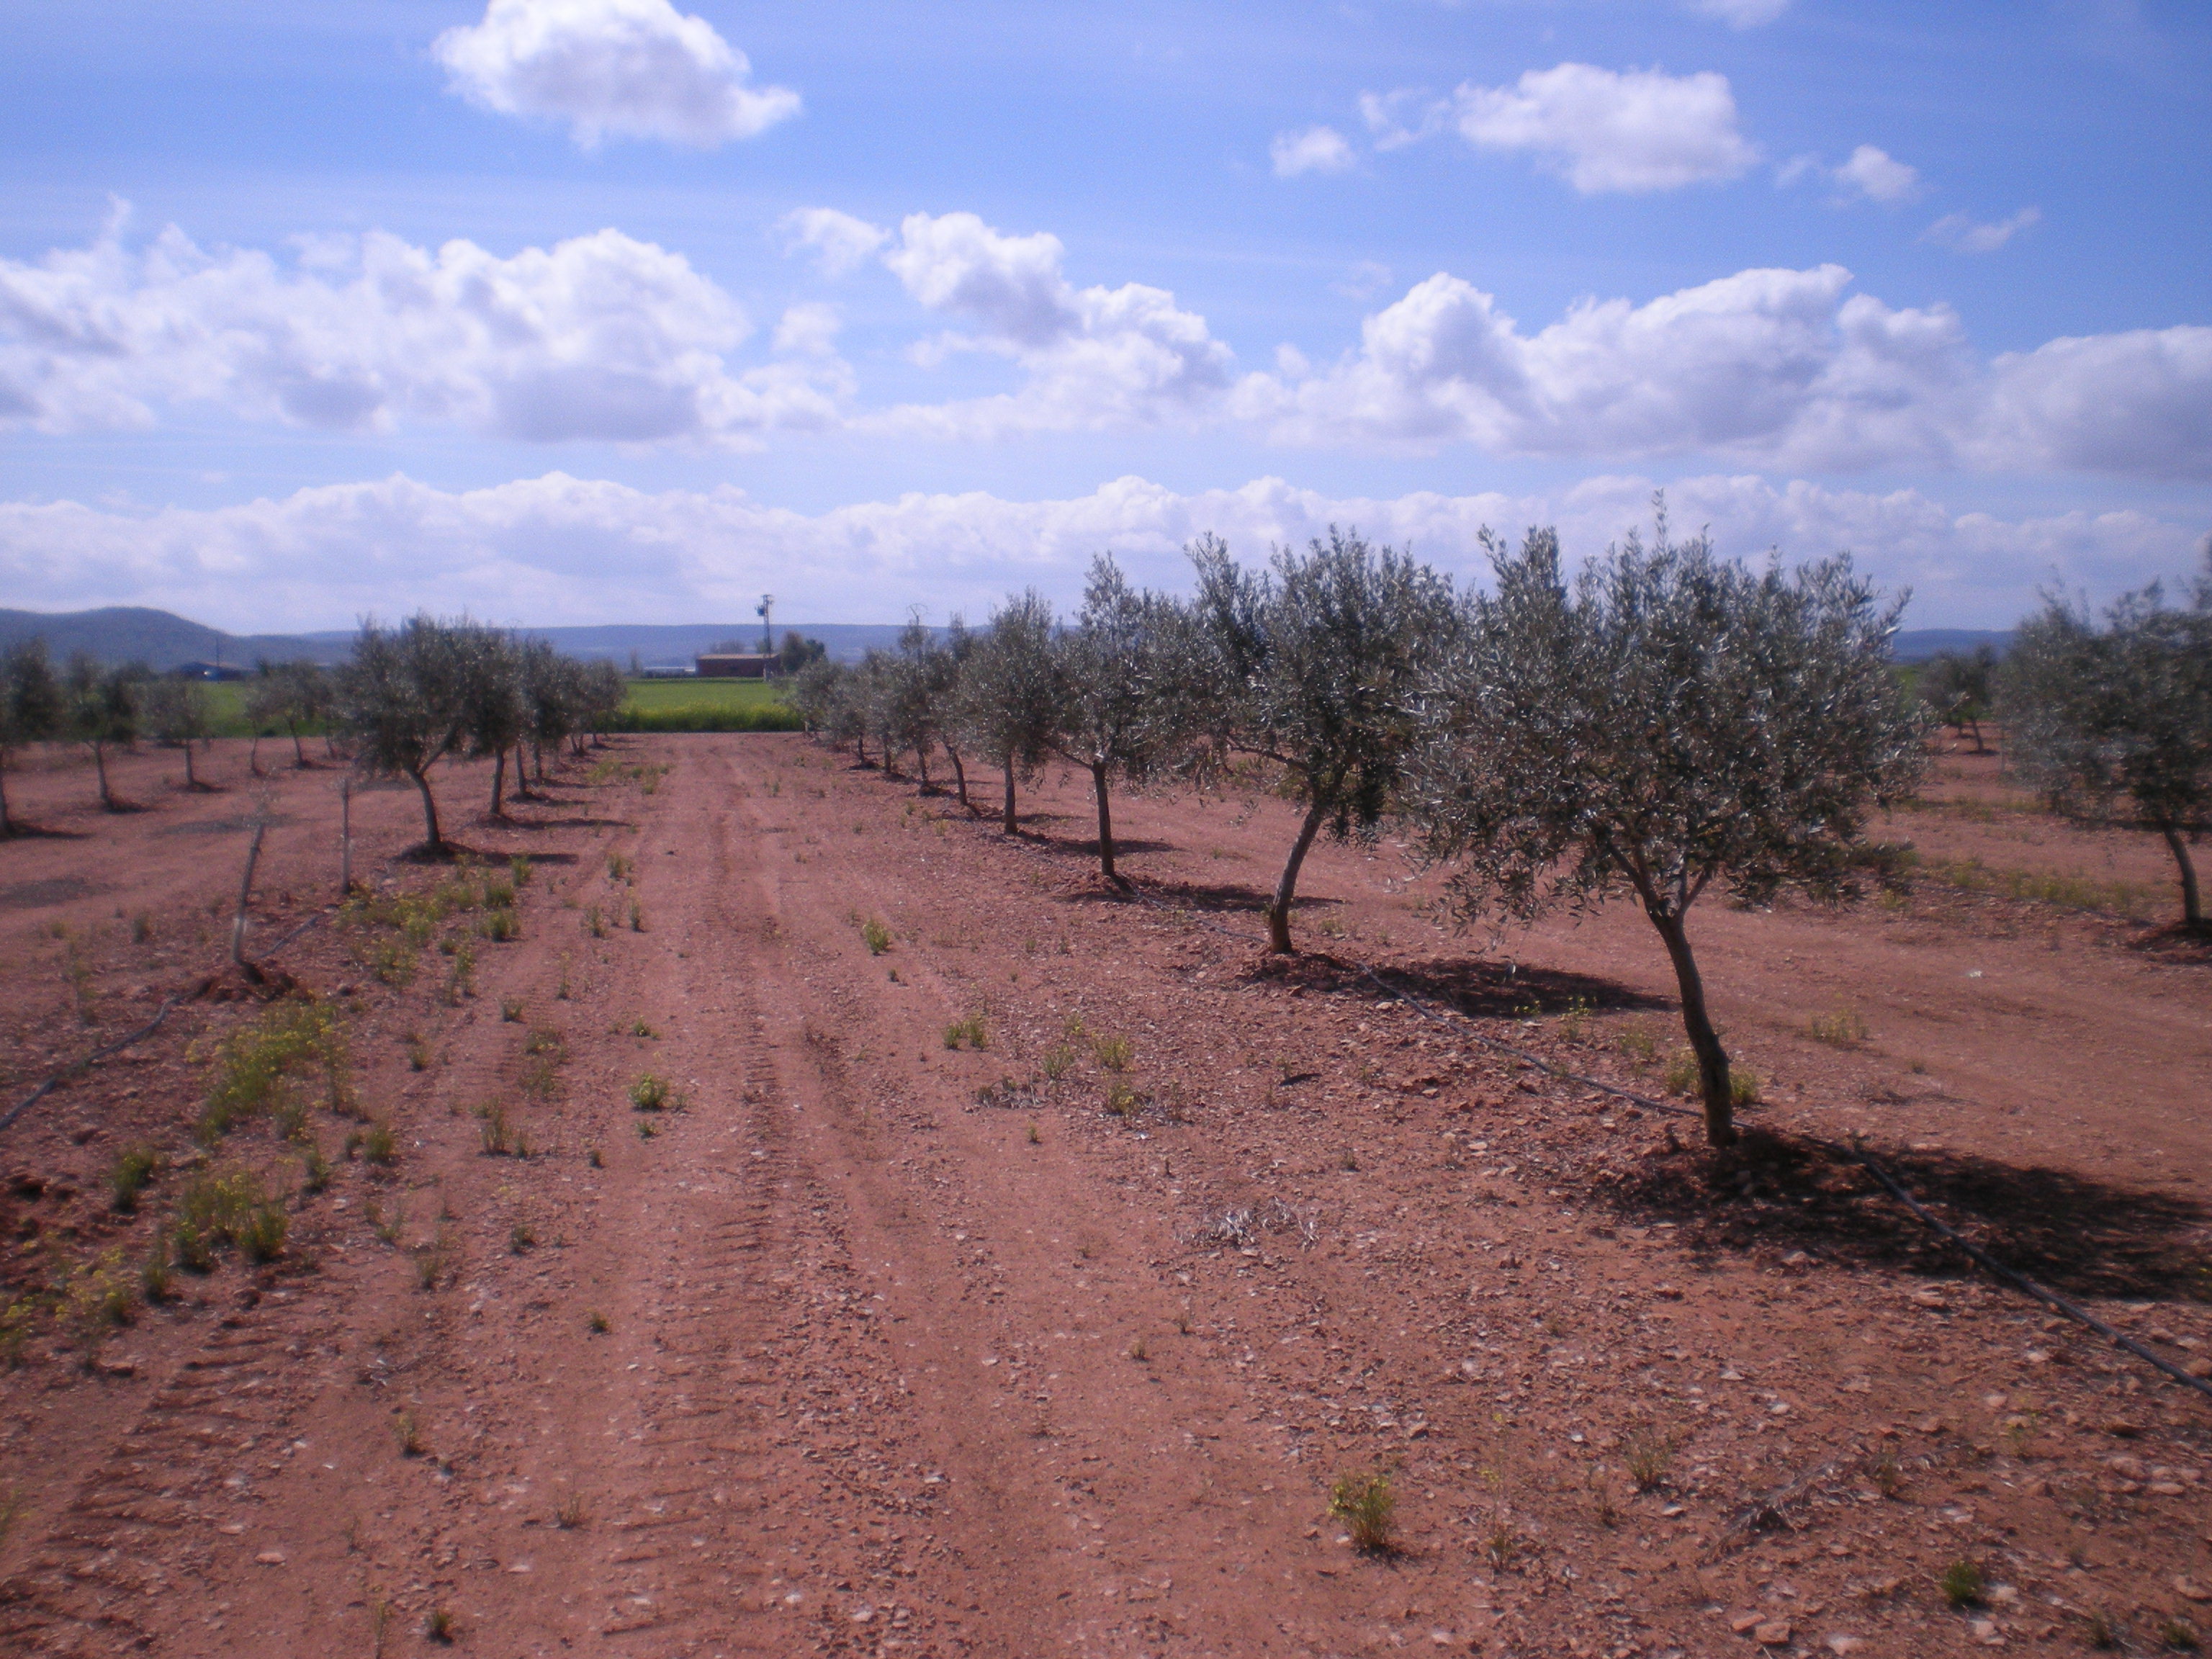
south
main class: Cropland
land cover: Olive groves
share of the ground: < 10 %
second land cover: Other bare soil
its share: > 75 %
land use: Agriculture (excluding fallow land and kitchen gardens)
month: April
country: ES
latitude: 38.9494
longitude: -3.5968
